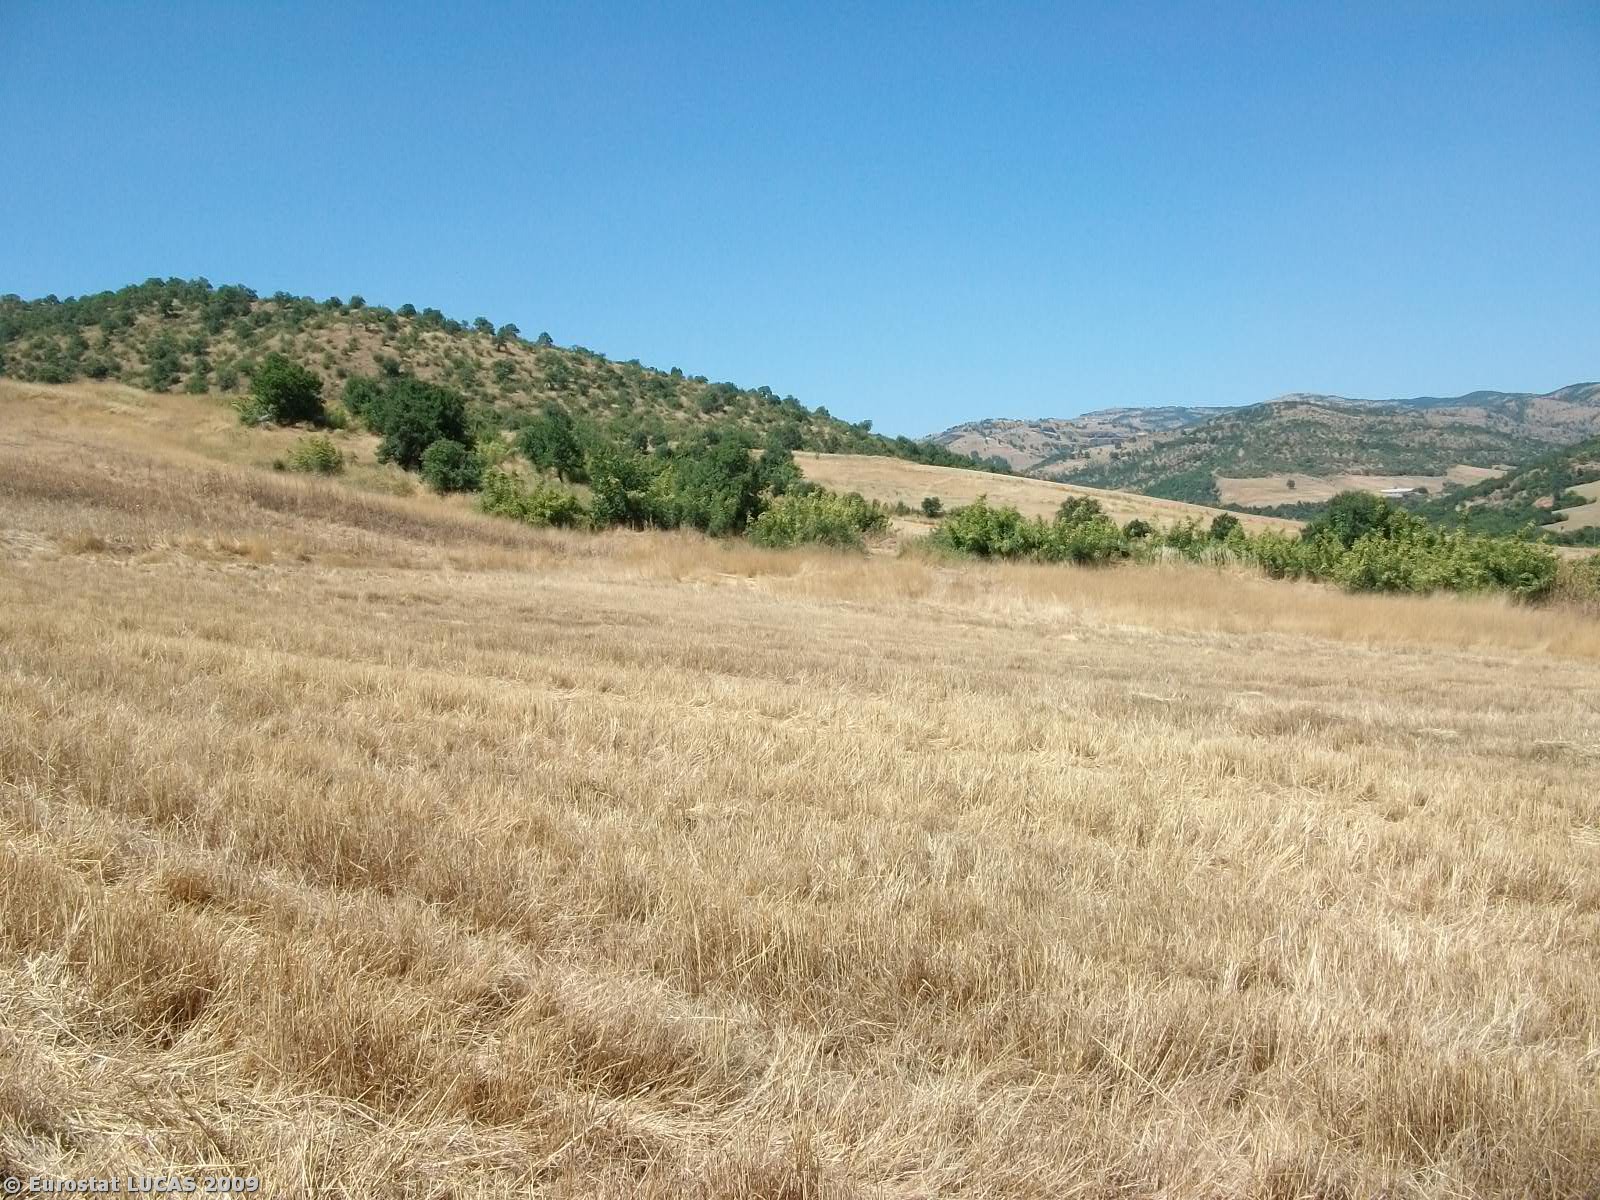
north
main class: Cropland
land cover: Durum wheat
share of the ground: < 10 %
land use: Agriculture (excluding fallow land and kitchen gardens)
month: July
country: GR
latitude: 39.7279
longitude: 21.7103
